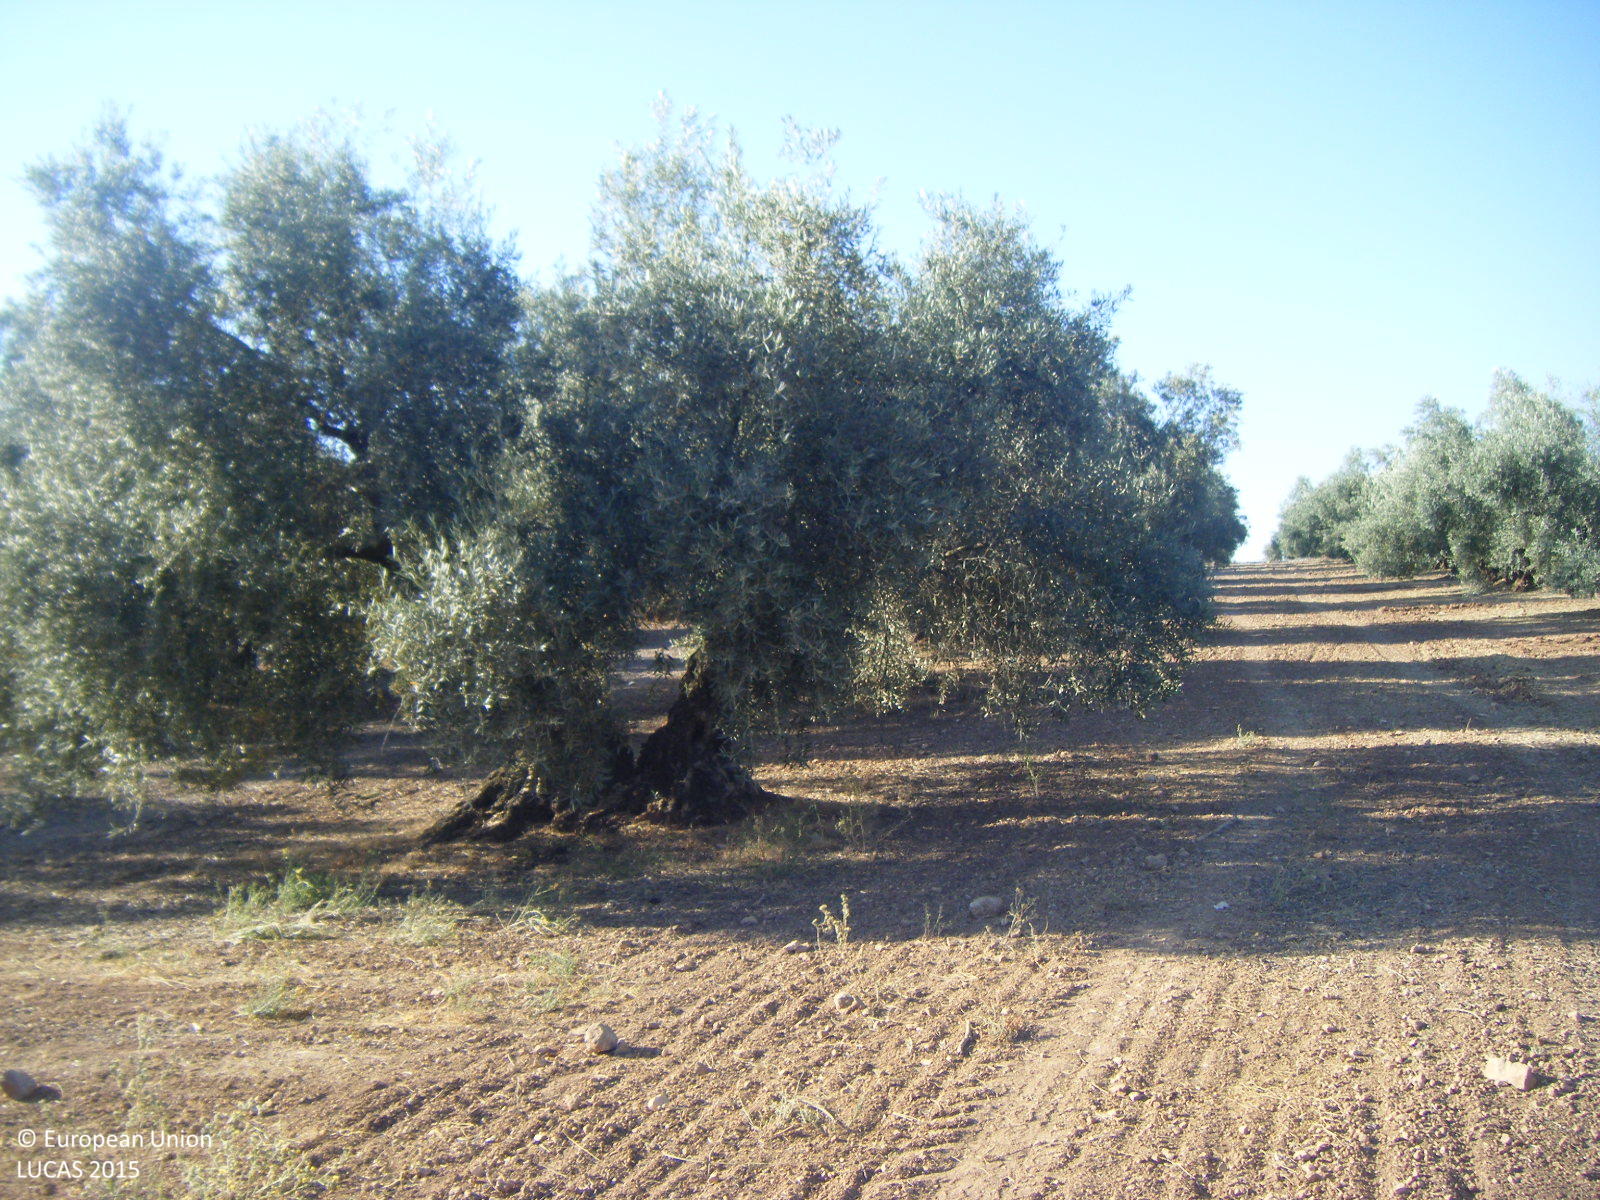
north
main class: Cropland
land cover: Olive groves
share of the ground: 25 - 50 %
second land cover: Other bare soil
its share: > 75 %
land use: Agriculture (excluding fallow land and kitchen gardens)
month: June
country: ES
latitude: 37.2993
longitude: -4.4518
